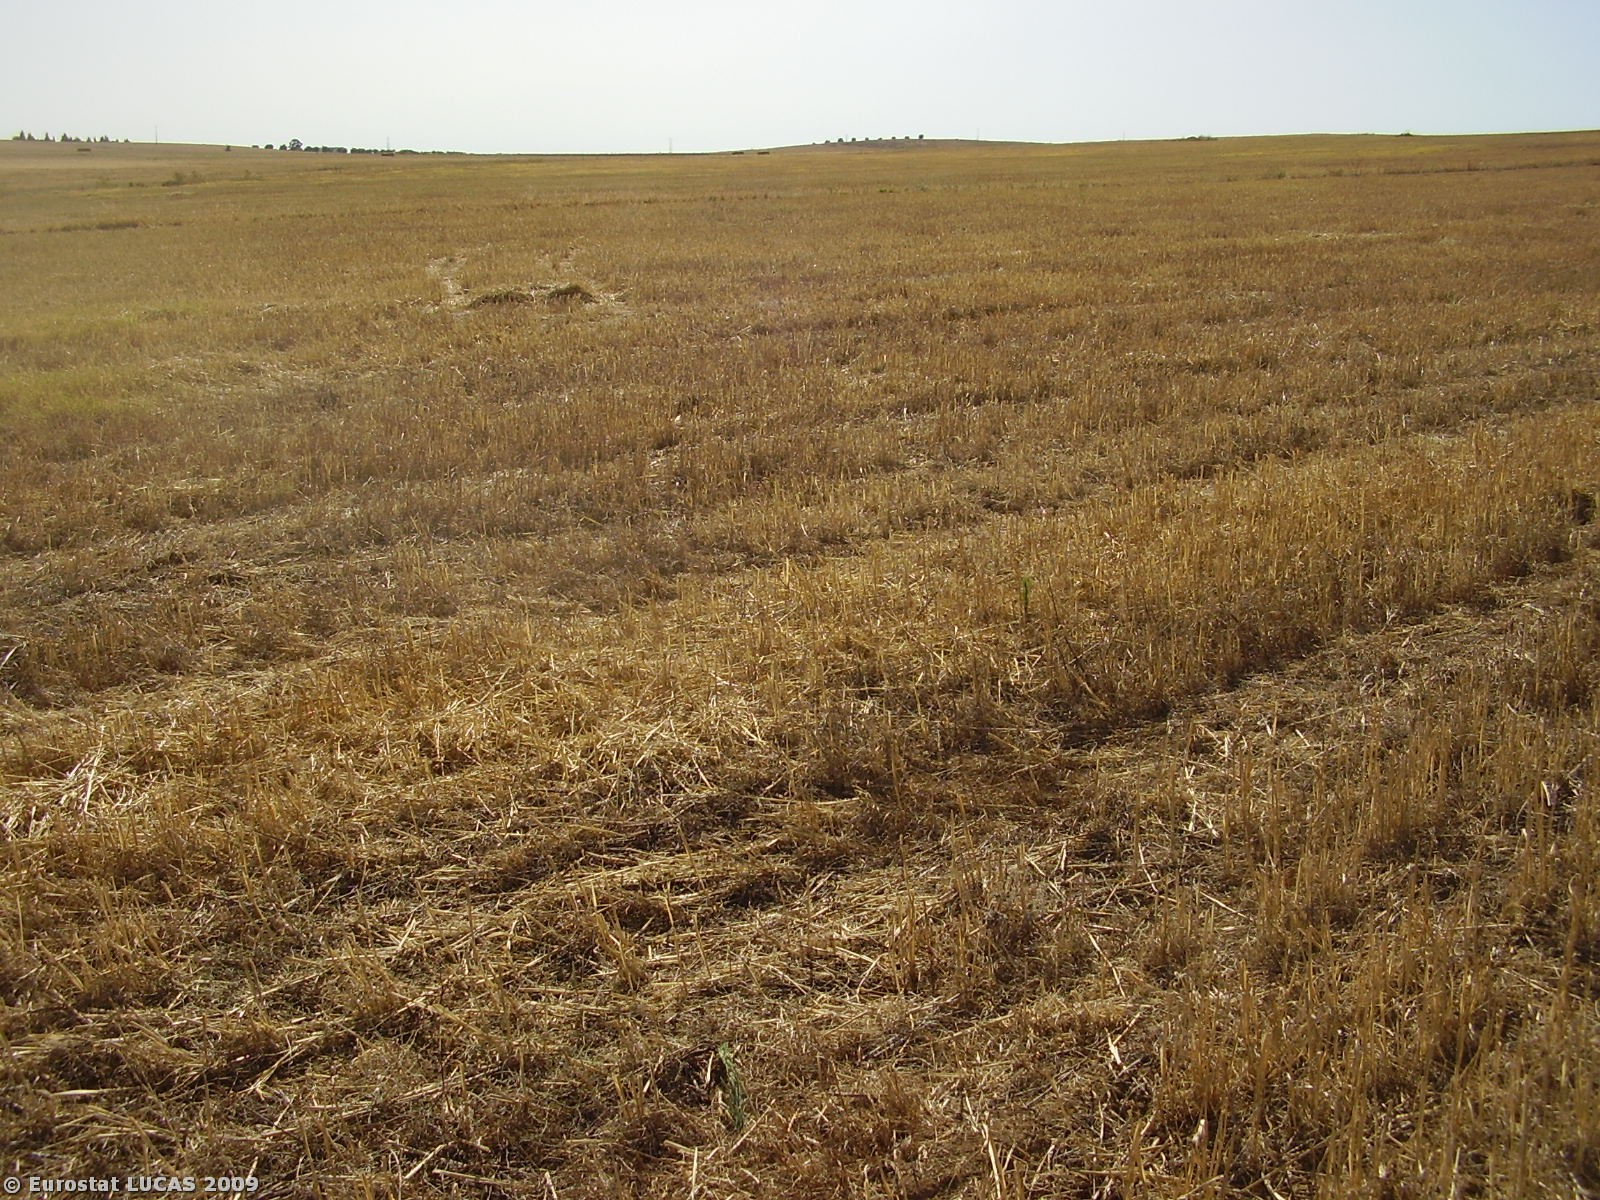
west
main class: Cropland
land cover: Common wheat
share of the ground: < 10 %
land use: Agriculture (excluding fallow land and kitchen gardens)
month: July
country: PT
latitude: 38.0169
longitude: -7.6905
